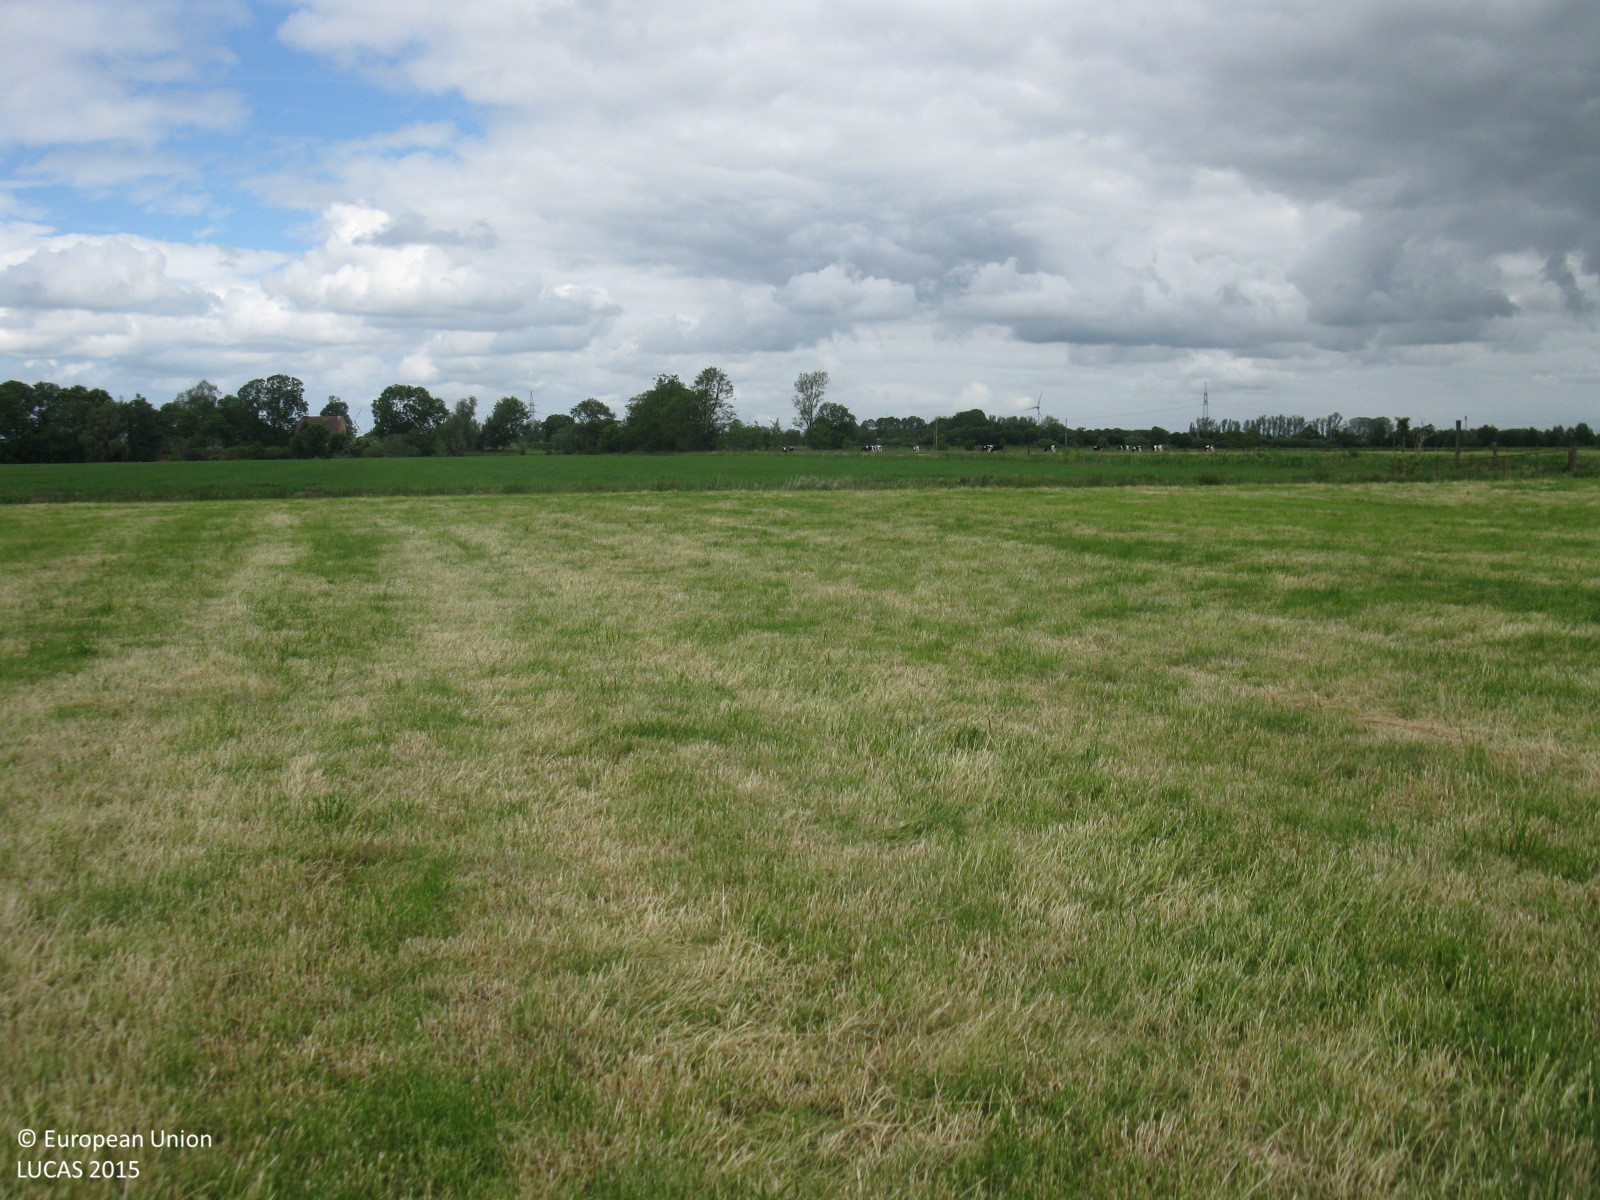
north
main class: Grassland
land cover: Grassland without tree/shrub cover
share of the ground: > 75 %
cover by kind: herbaceous plants 100 %
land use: Agriculture (excluding fallow land and kitchen gardens)
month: June
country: DE
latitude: 53.3195
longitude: 7.3735
